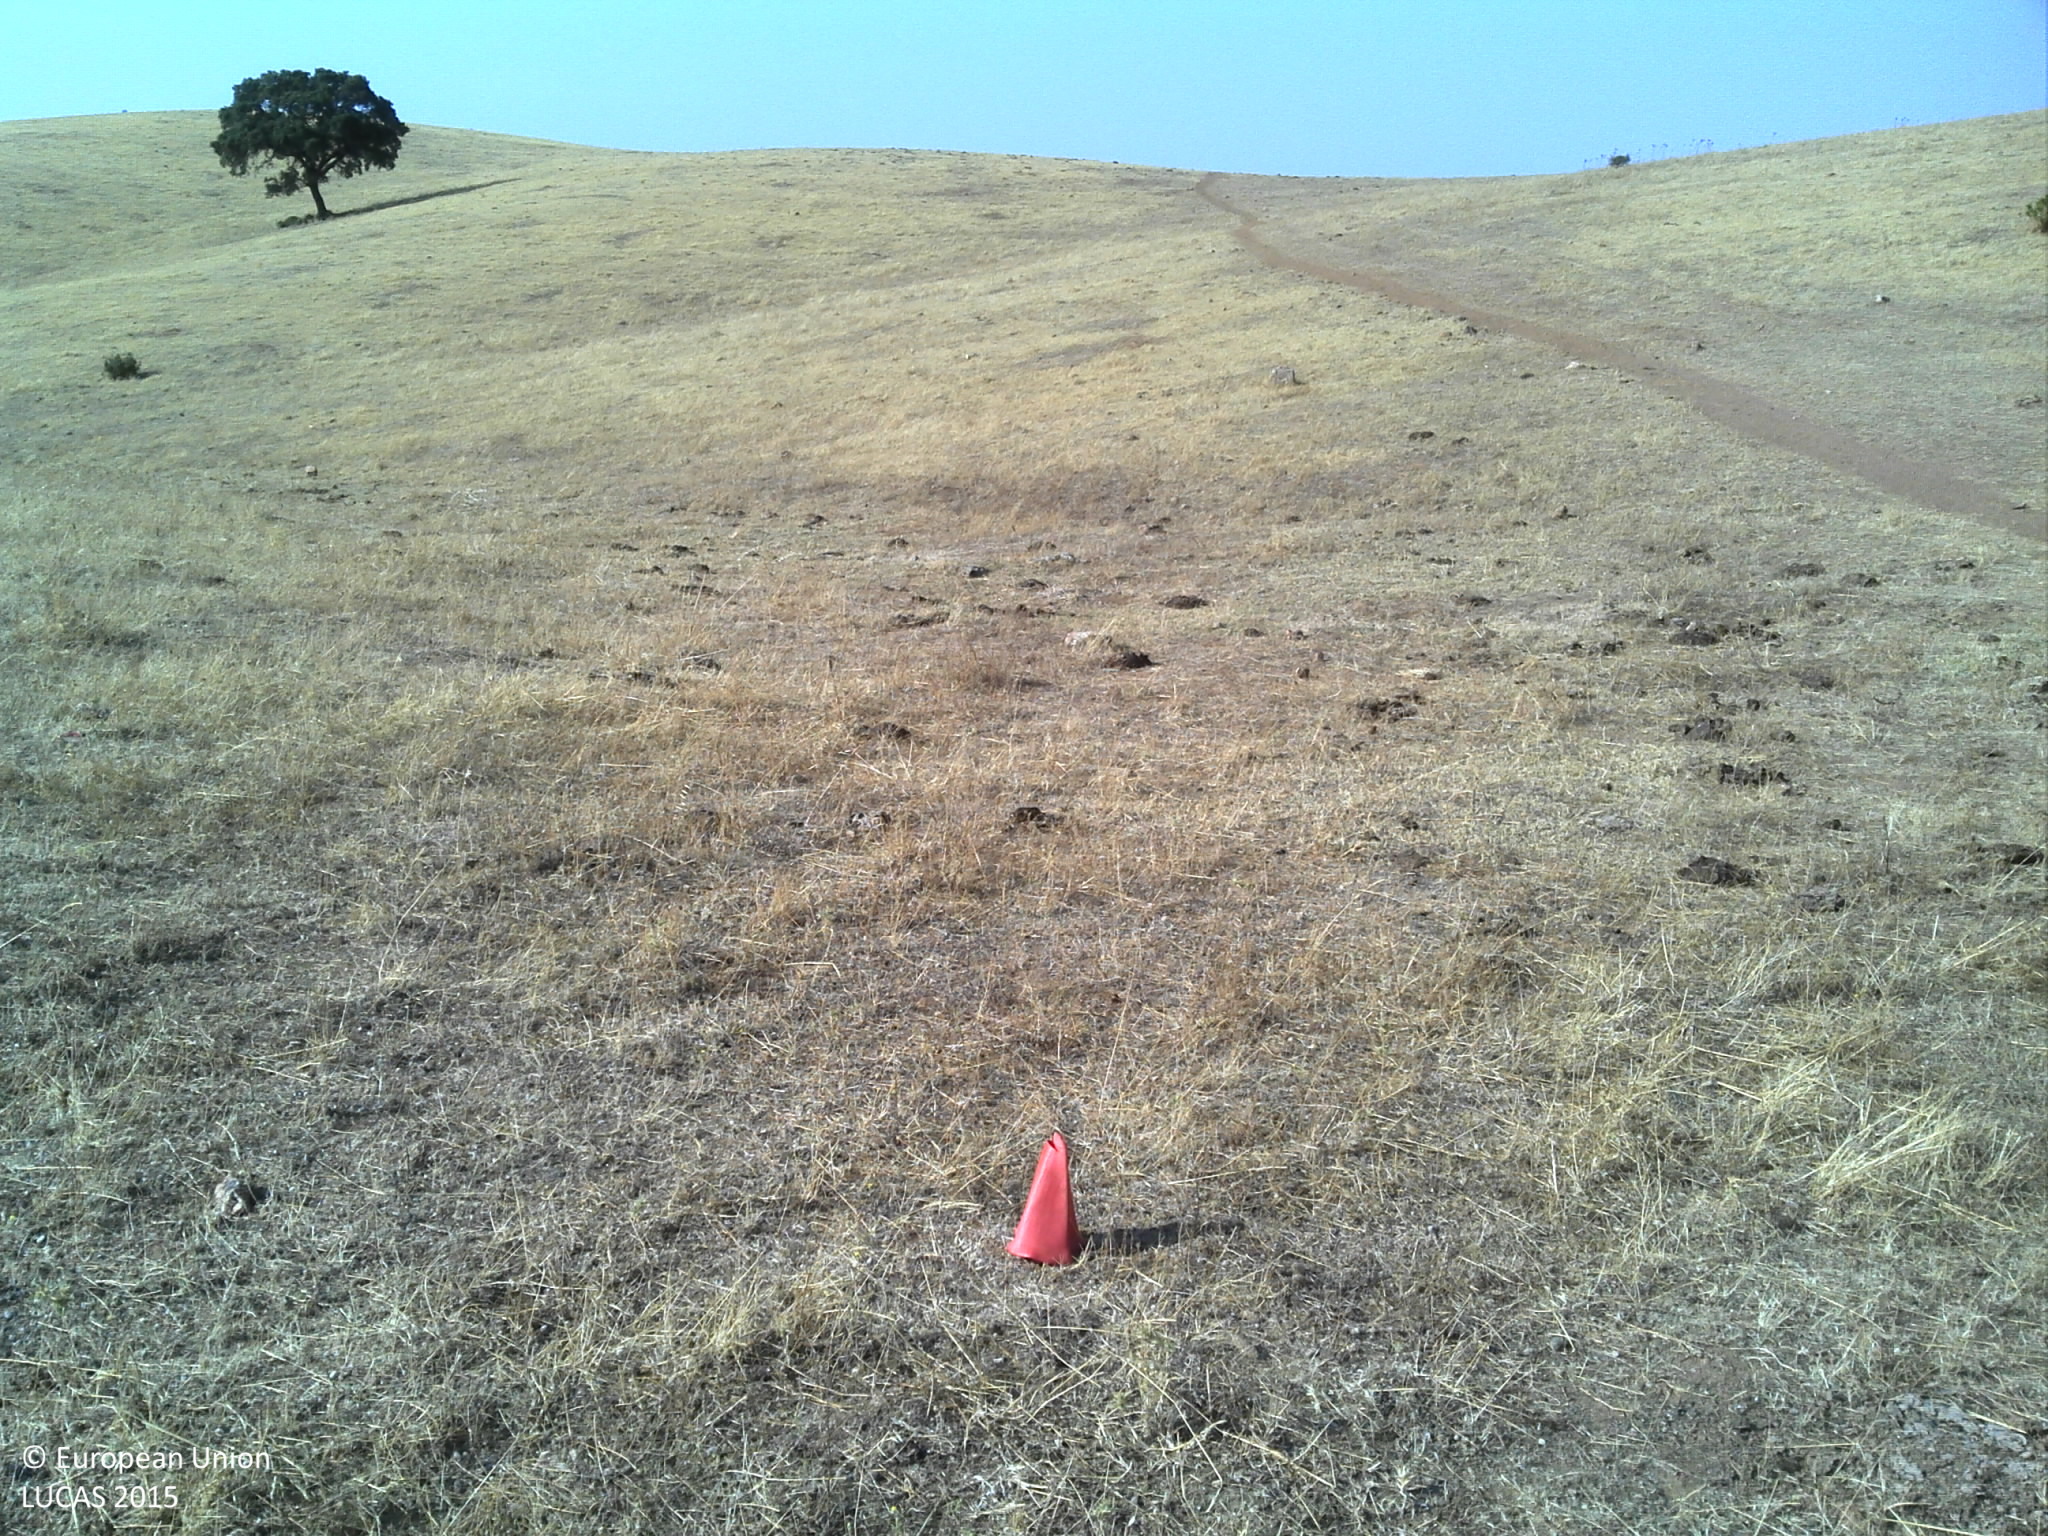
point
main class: Grassland
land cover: Grassland without tree/shrub cover
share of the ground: 10 - 25 %
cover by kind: unconsolidated bare surface 85 %, herbaceous plants 15 %
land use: Agriculture (excluding fallow land and kitchen gardens)
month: July
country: PT
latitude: 37.8292
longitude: -7.8036
